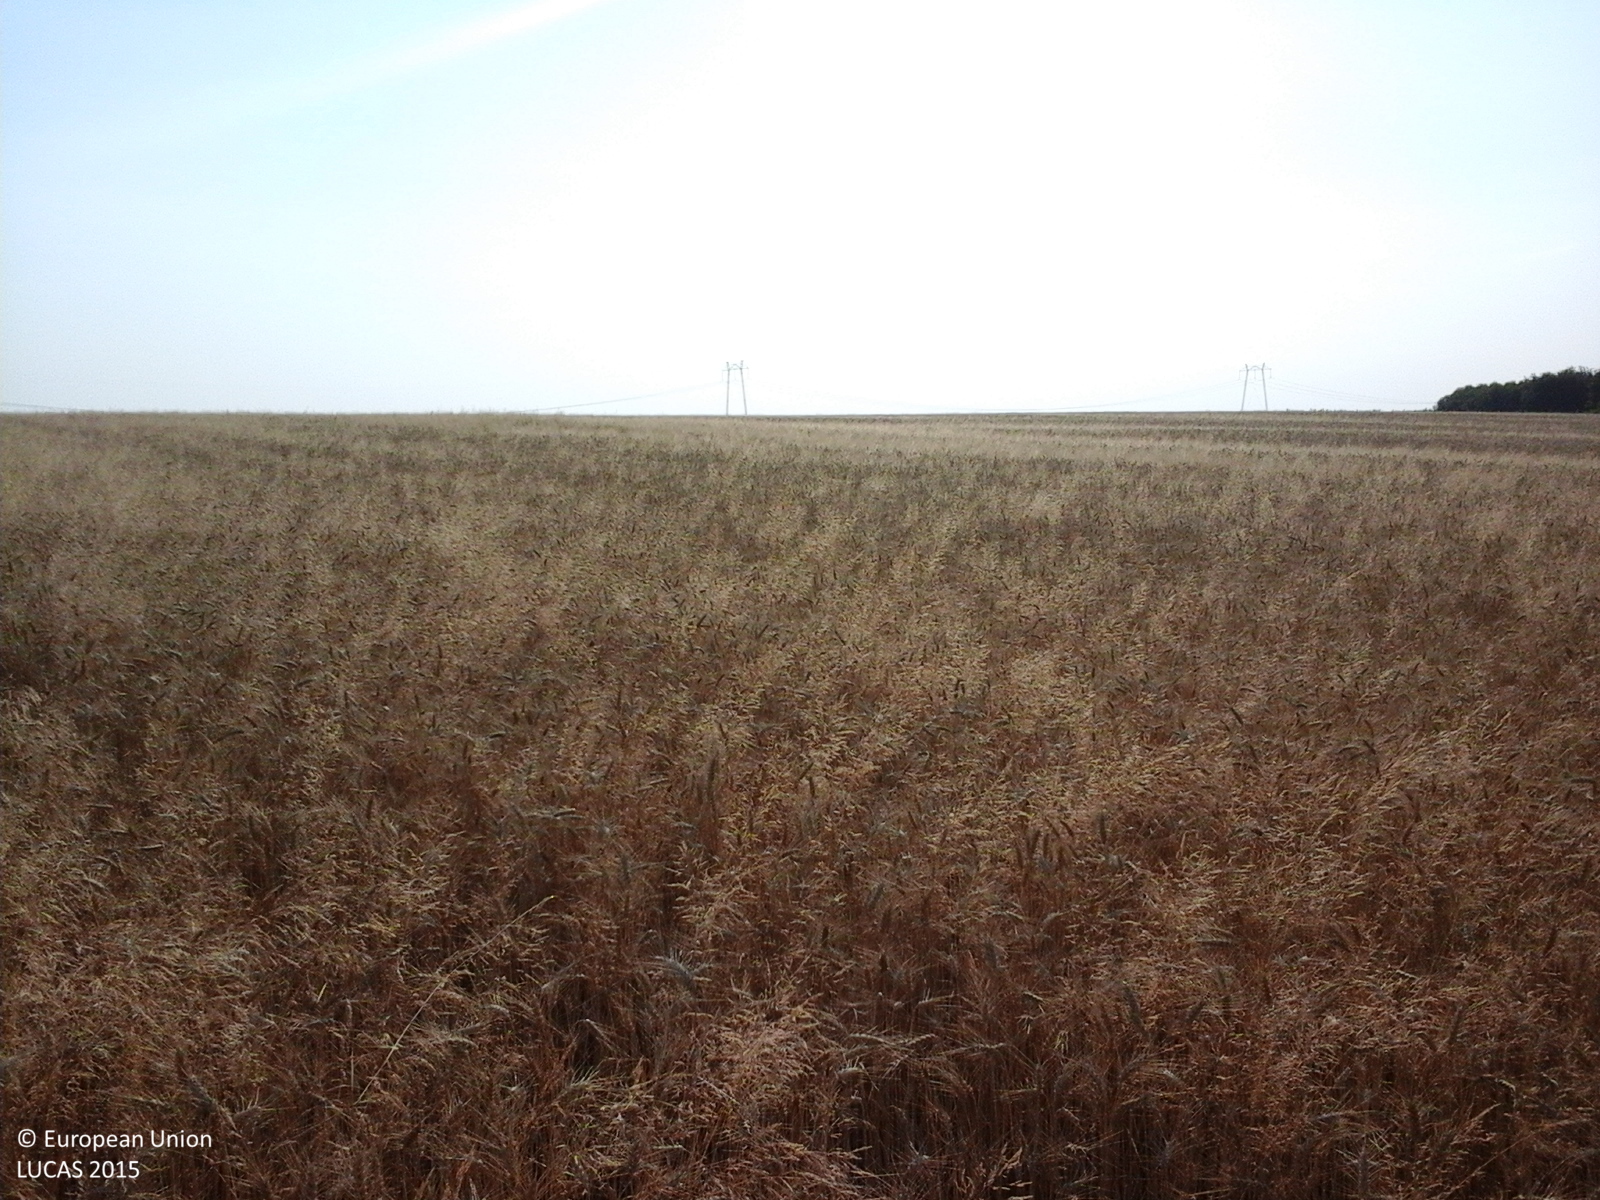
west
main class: Cropland
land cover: Common wheat
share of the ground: > 75 %
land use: Agriculture (excluding fallow land and kitchen gardens)
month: July
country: RO
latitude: 44.6882
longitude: 24.7005
